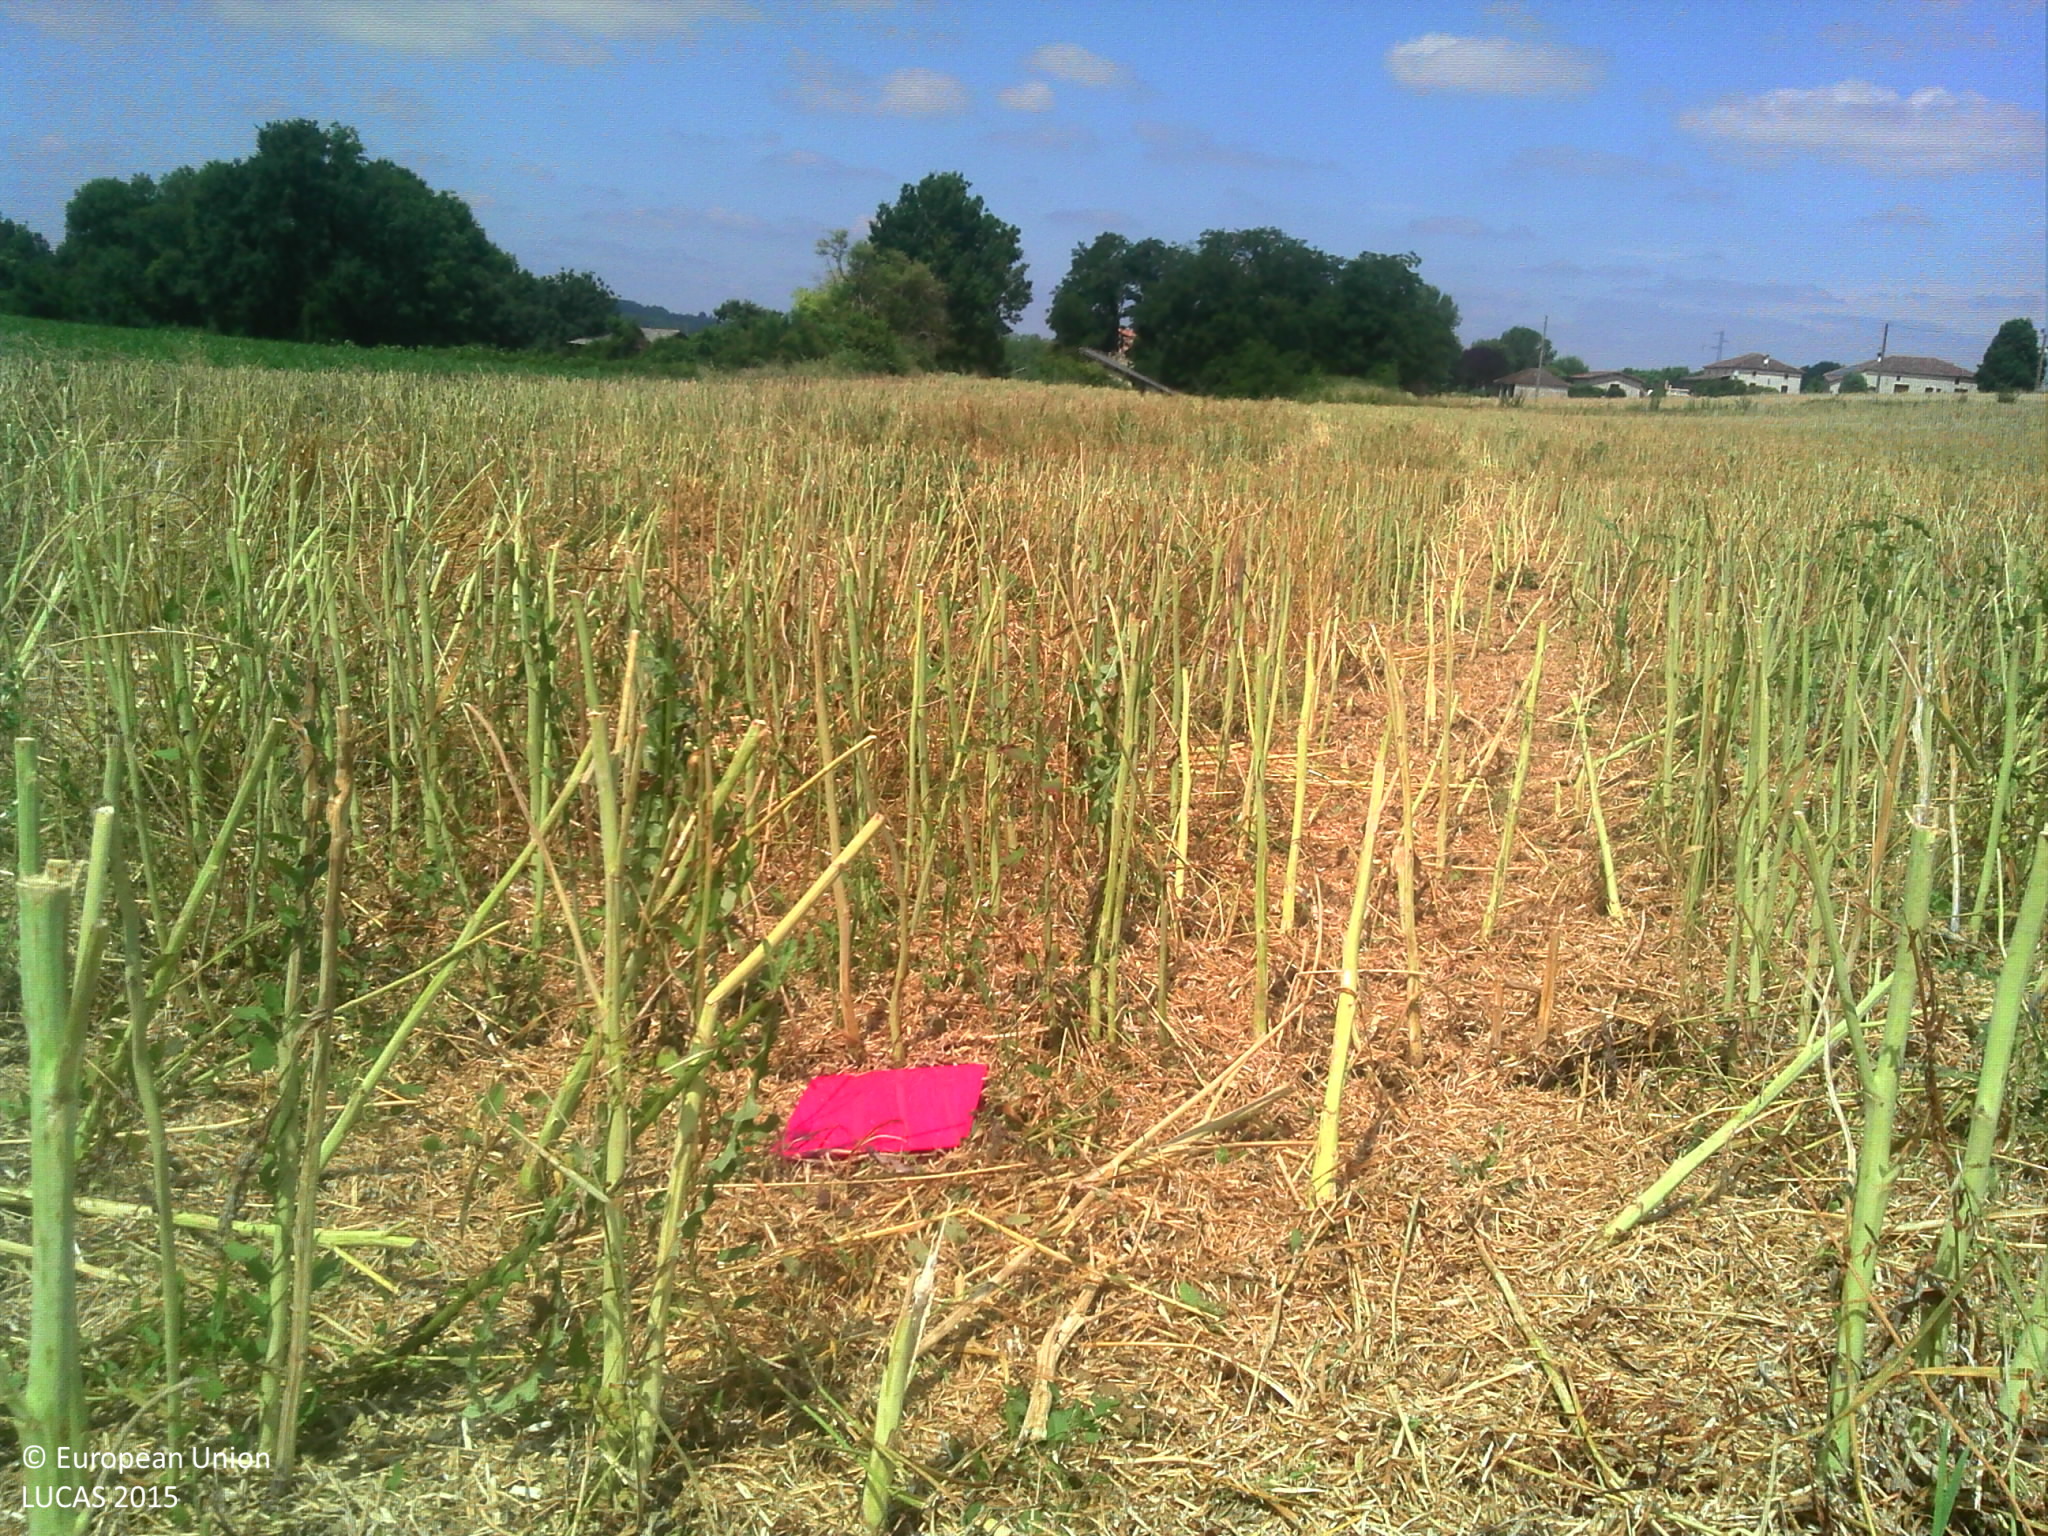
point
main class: Cropland
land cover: Rape and turnip rape
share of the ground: 25 - 50 %
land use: Agriculture (excluding fallow land and kitchen gardens)
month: June
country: FR
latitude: 44.1524
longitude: 0.9323
